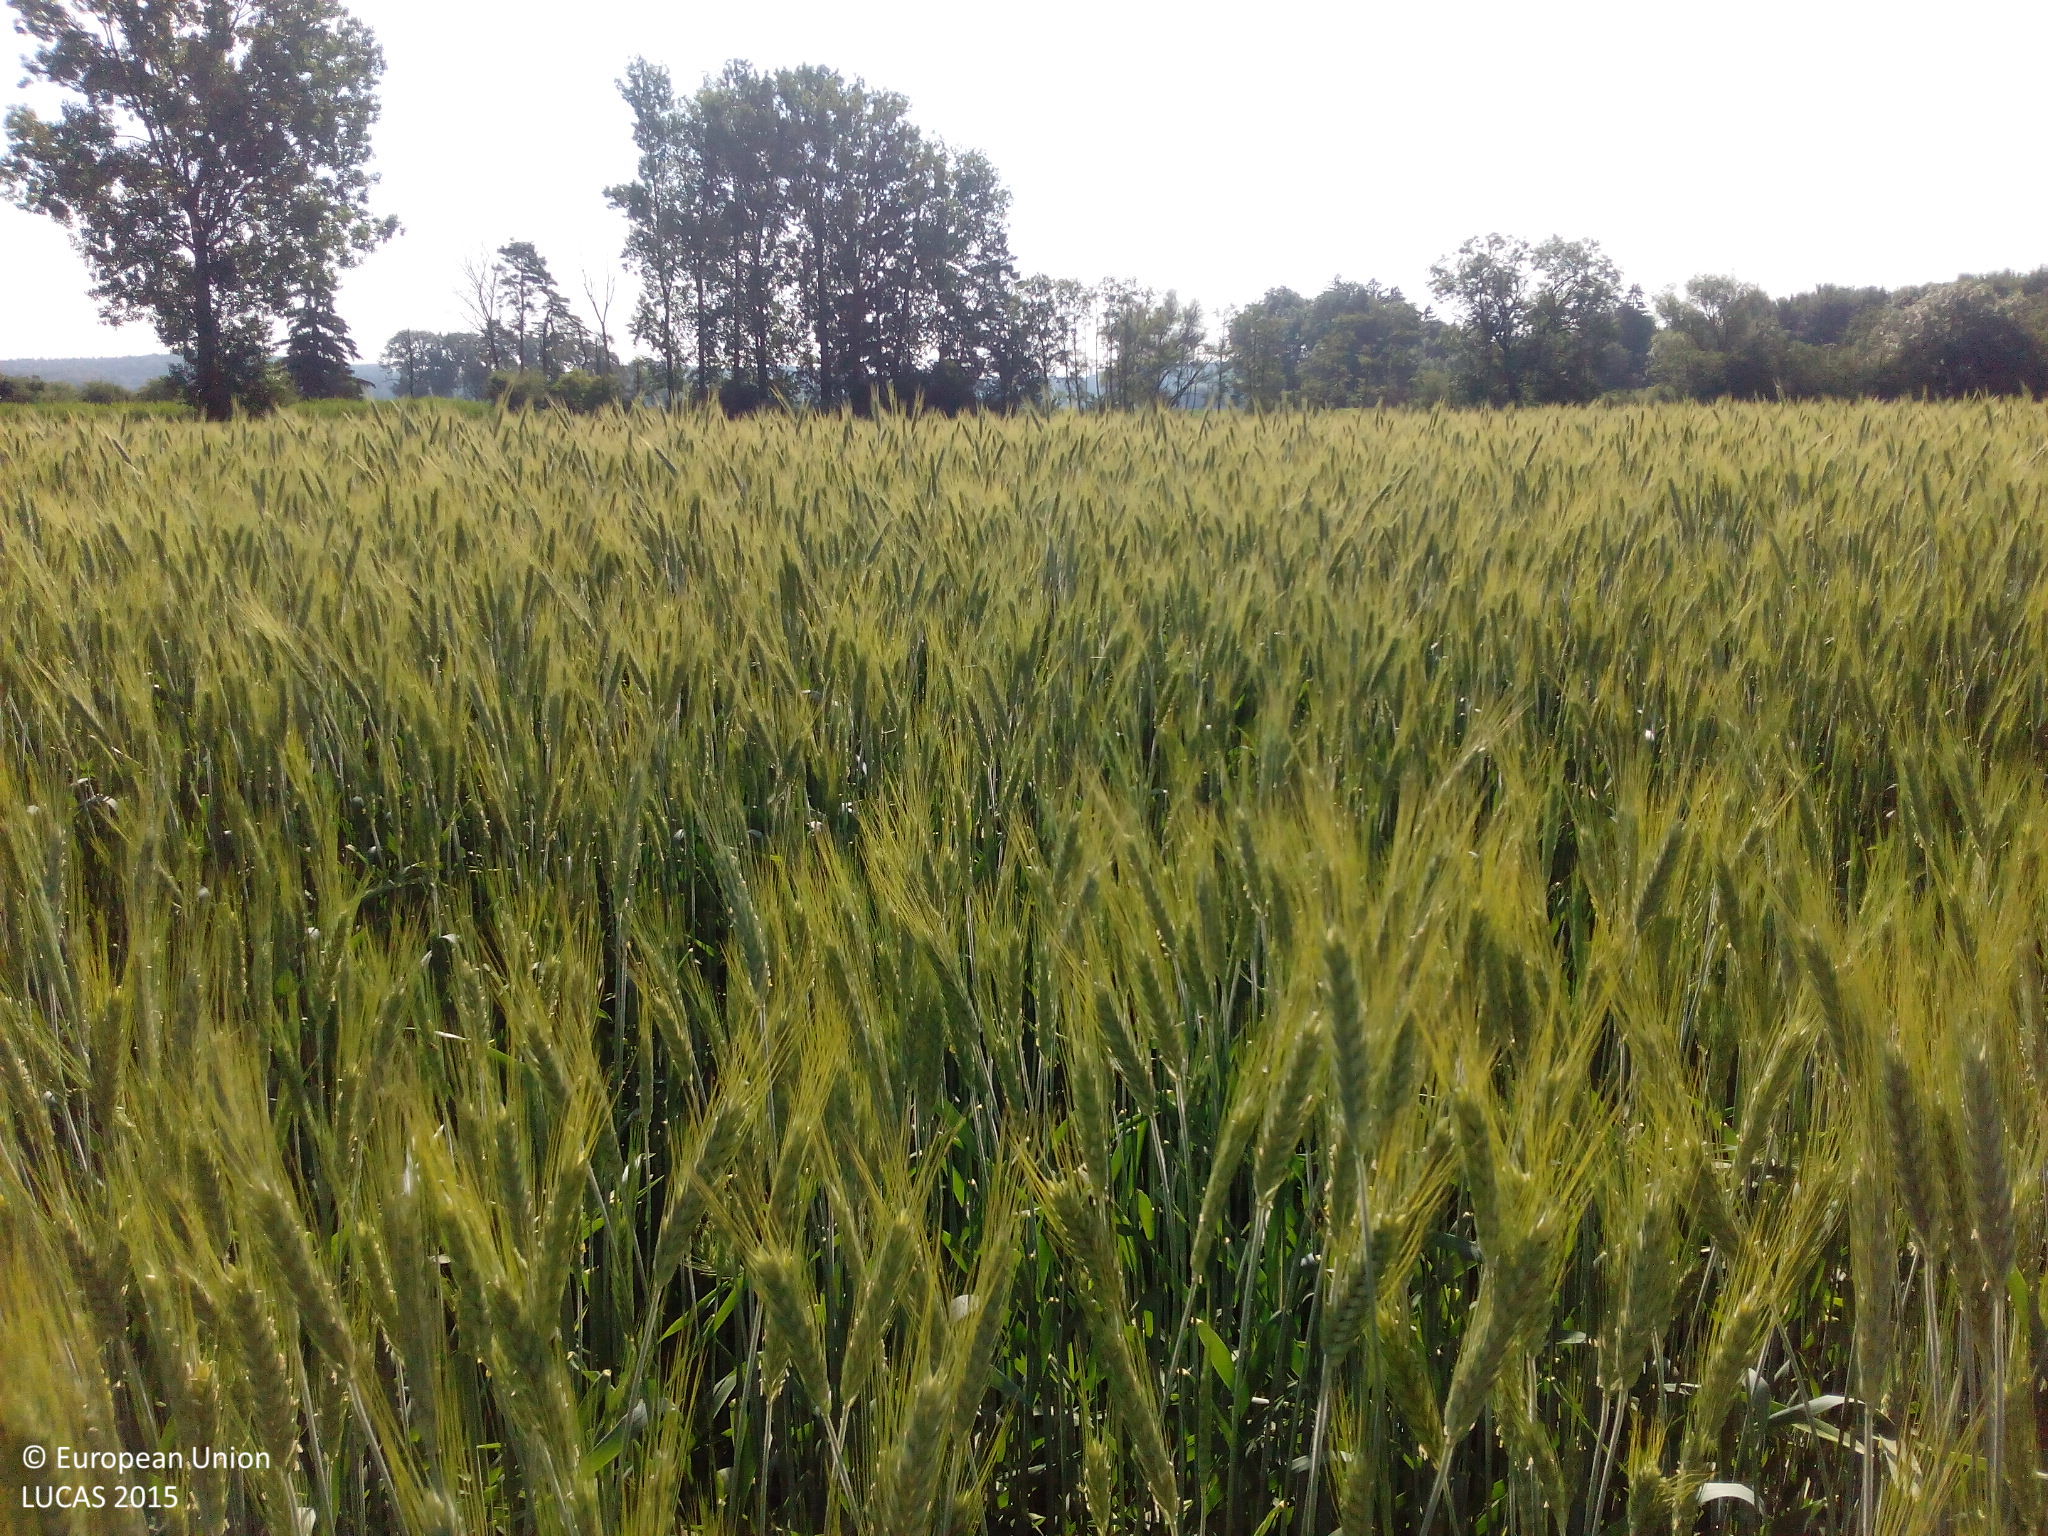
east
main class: Cropland
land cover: Rye
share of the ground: > 75 %
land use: Agriculture (excluding fallow land and kitchen gardens)
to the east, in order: Rye; Common wheat; Abandoned hedges; Inland fresh running water; Broadleaved woodland; Shruby margins; Common wheat
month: June
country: DE
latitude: 48.5799
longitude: 10.8806
